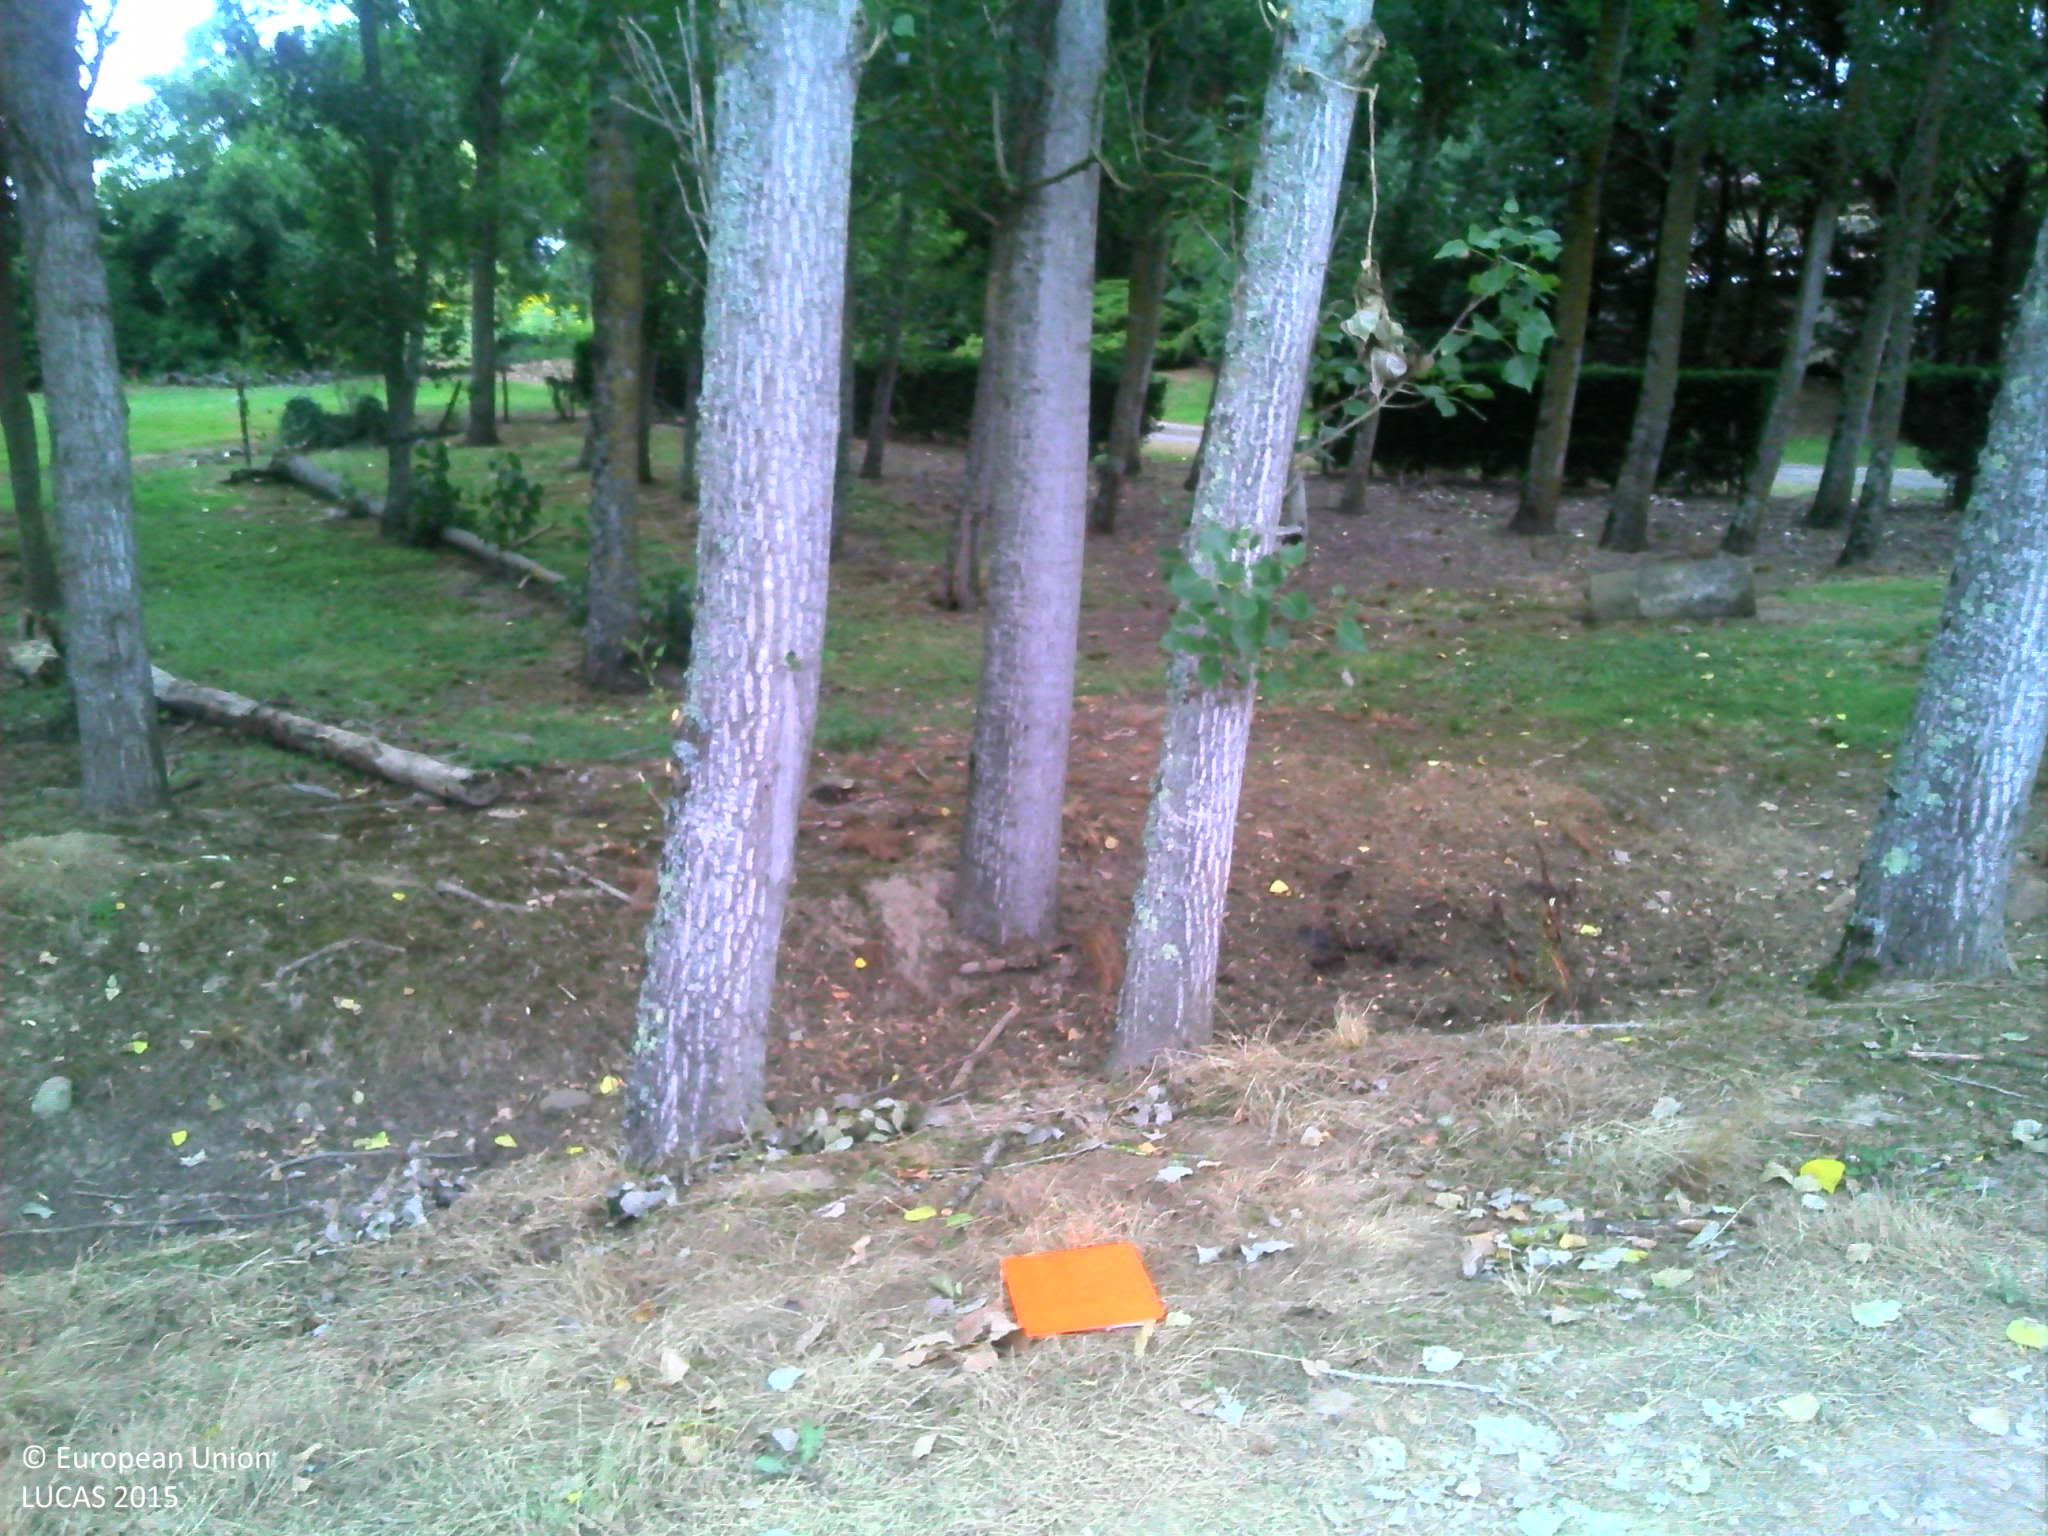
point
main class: Woodland
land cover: Broadleaved woodland
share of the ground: > 75 %
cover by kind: broadleaved forest trees 65 %, herbaceous plants 30 %, consolidated bare surface 5 %
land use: Residential
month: July
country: FR
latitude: 43.6822
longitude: -0.5676
